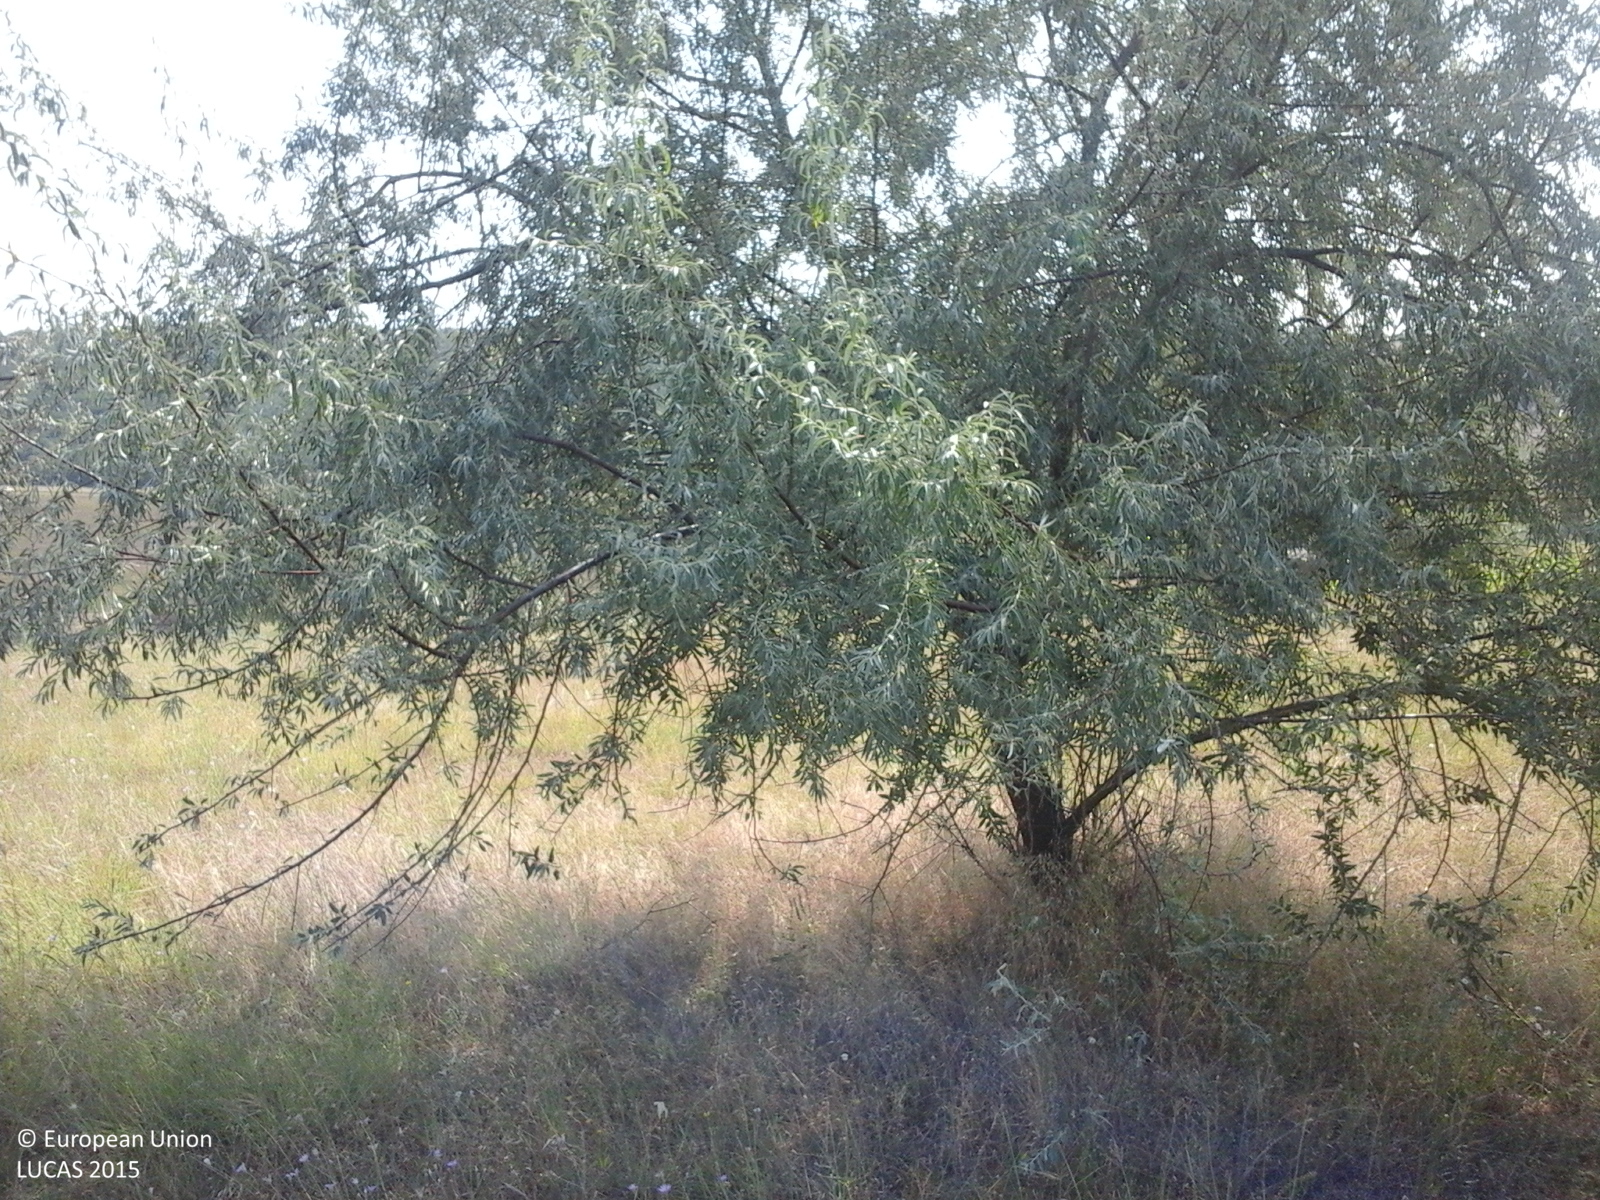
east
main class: Grassland
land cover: Grassland with sparse tree/shrub cover
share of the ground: > 75 %
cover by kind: herbaceous plants 95 %, broadleaved forest trees 5 %
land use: Agriculture (excluding fallow land and kitchen gardens)
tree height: > 5 m
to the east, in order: Grassland with sparse tree/shrub cover; Grassland without tree/shrub cover; Tracks; Grassland without tree/shrub cover; Lines of trees; Ditches and canals; Grassland without tree/shrub cover
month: July
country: RO
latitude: 46.0525
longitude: 27.8372
